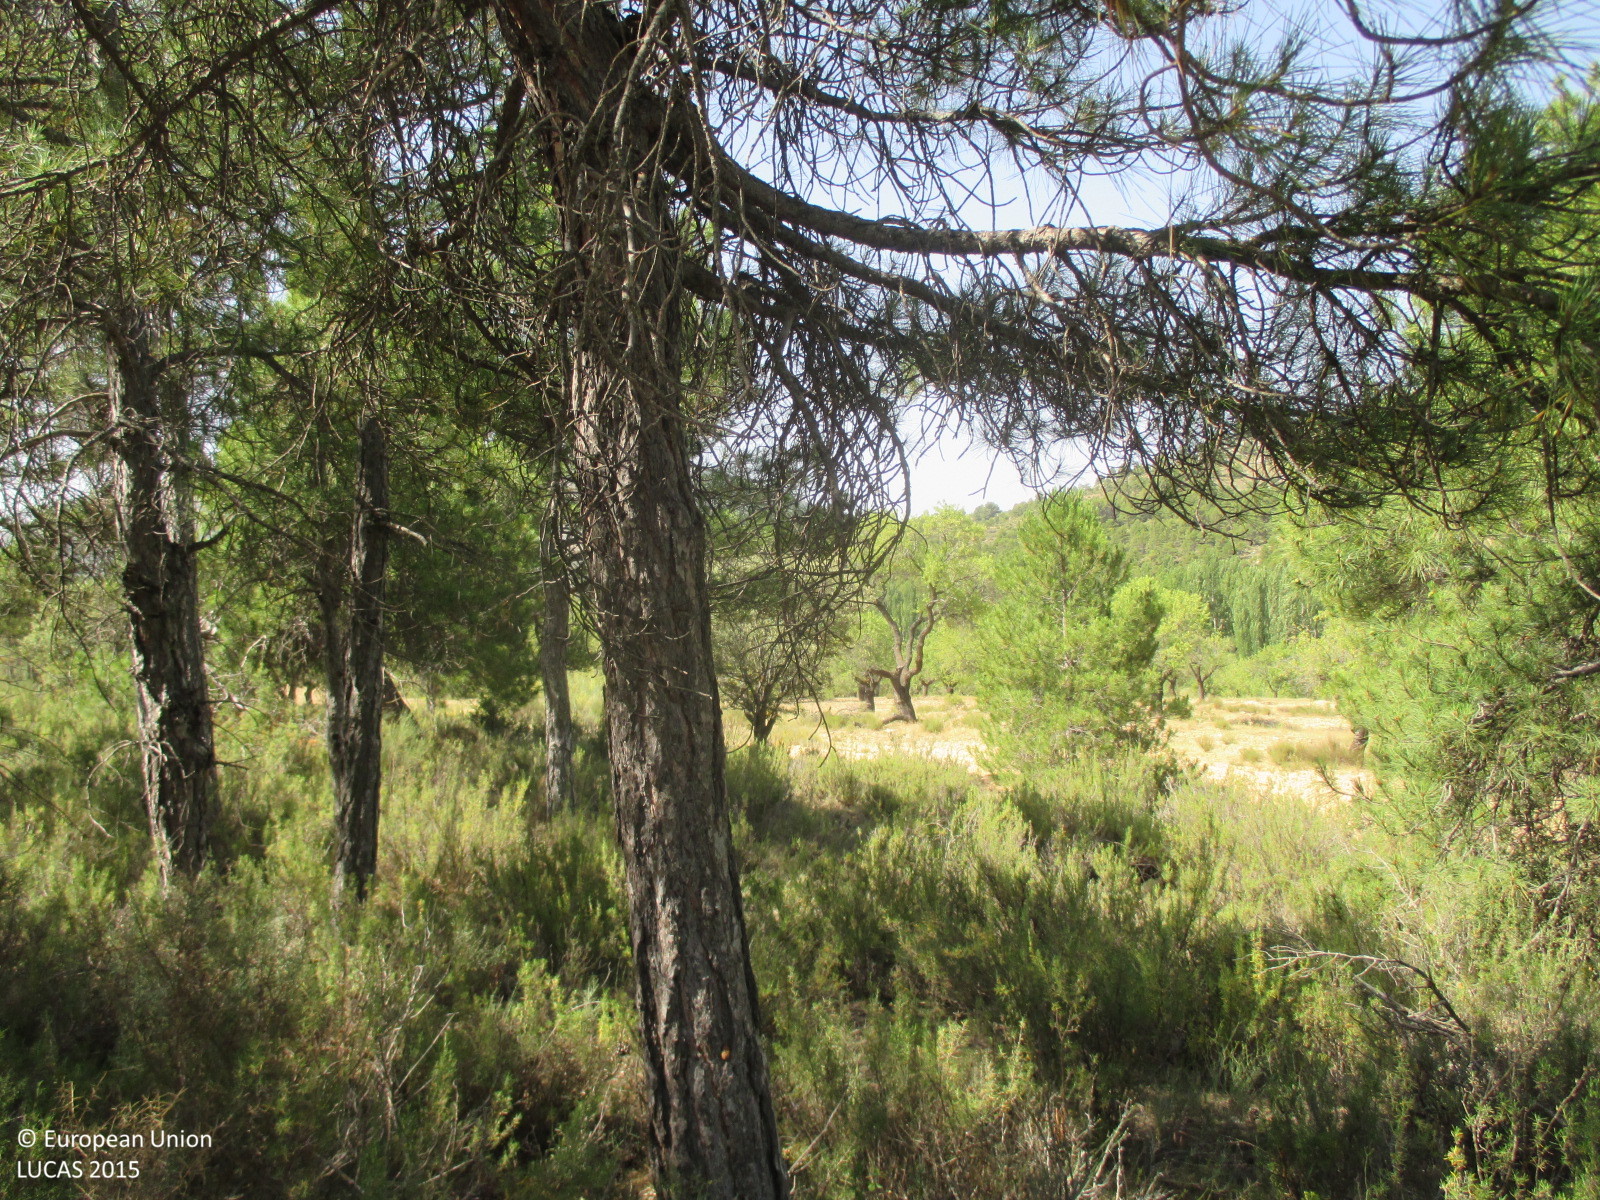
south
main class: Woodland
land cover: Pine dominated coniferous woodland
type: coniferous forest of the mediterranean region
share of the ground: 50 - 75 %
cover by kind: coniferous forest trees 60 %, shrubs 20 %, herbaceous plants 20 %
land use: Forestry
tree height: > 5 m
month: July
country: ES
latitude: 37.9874
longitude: -2.4595
